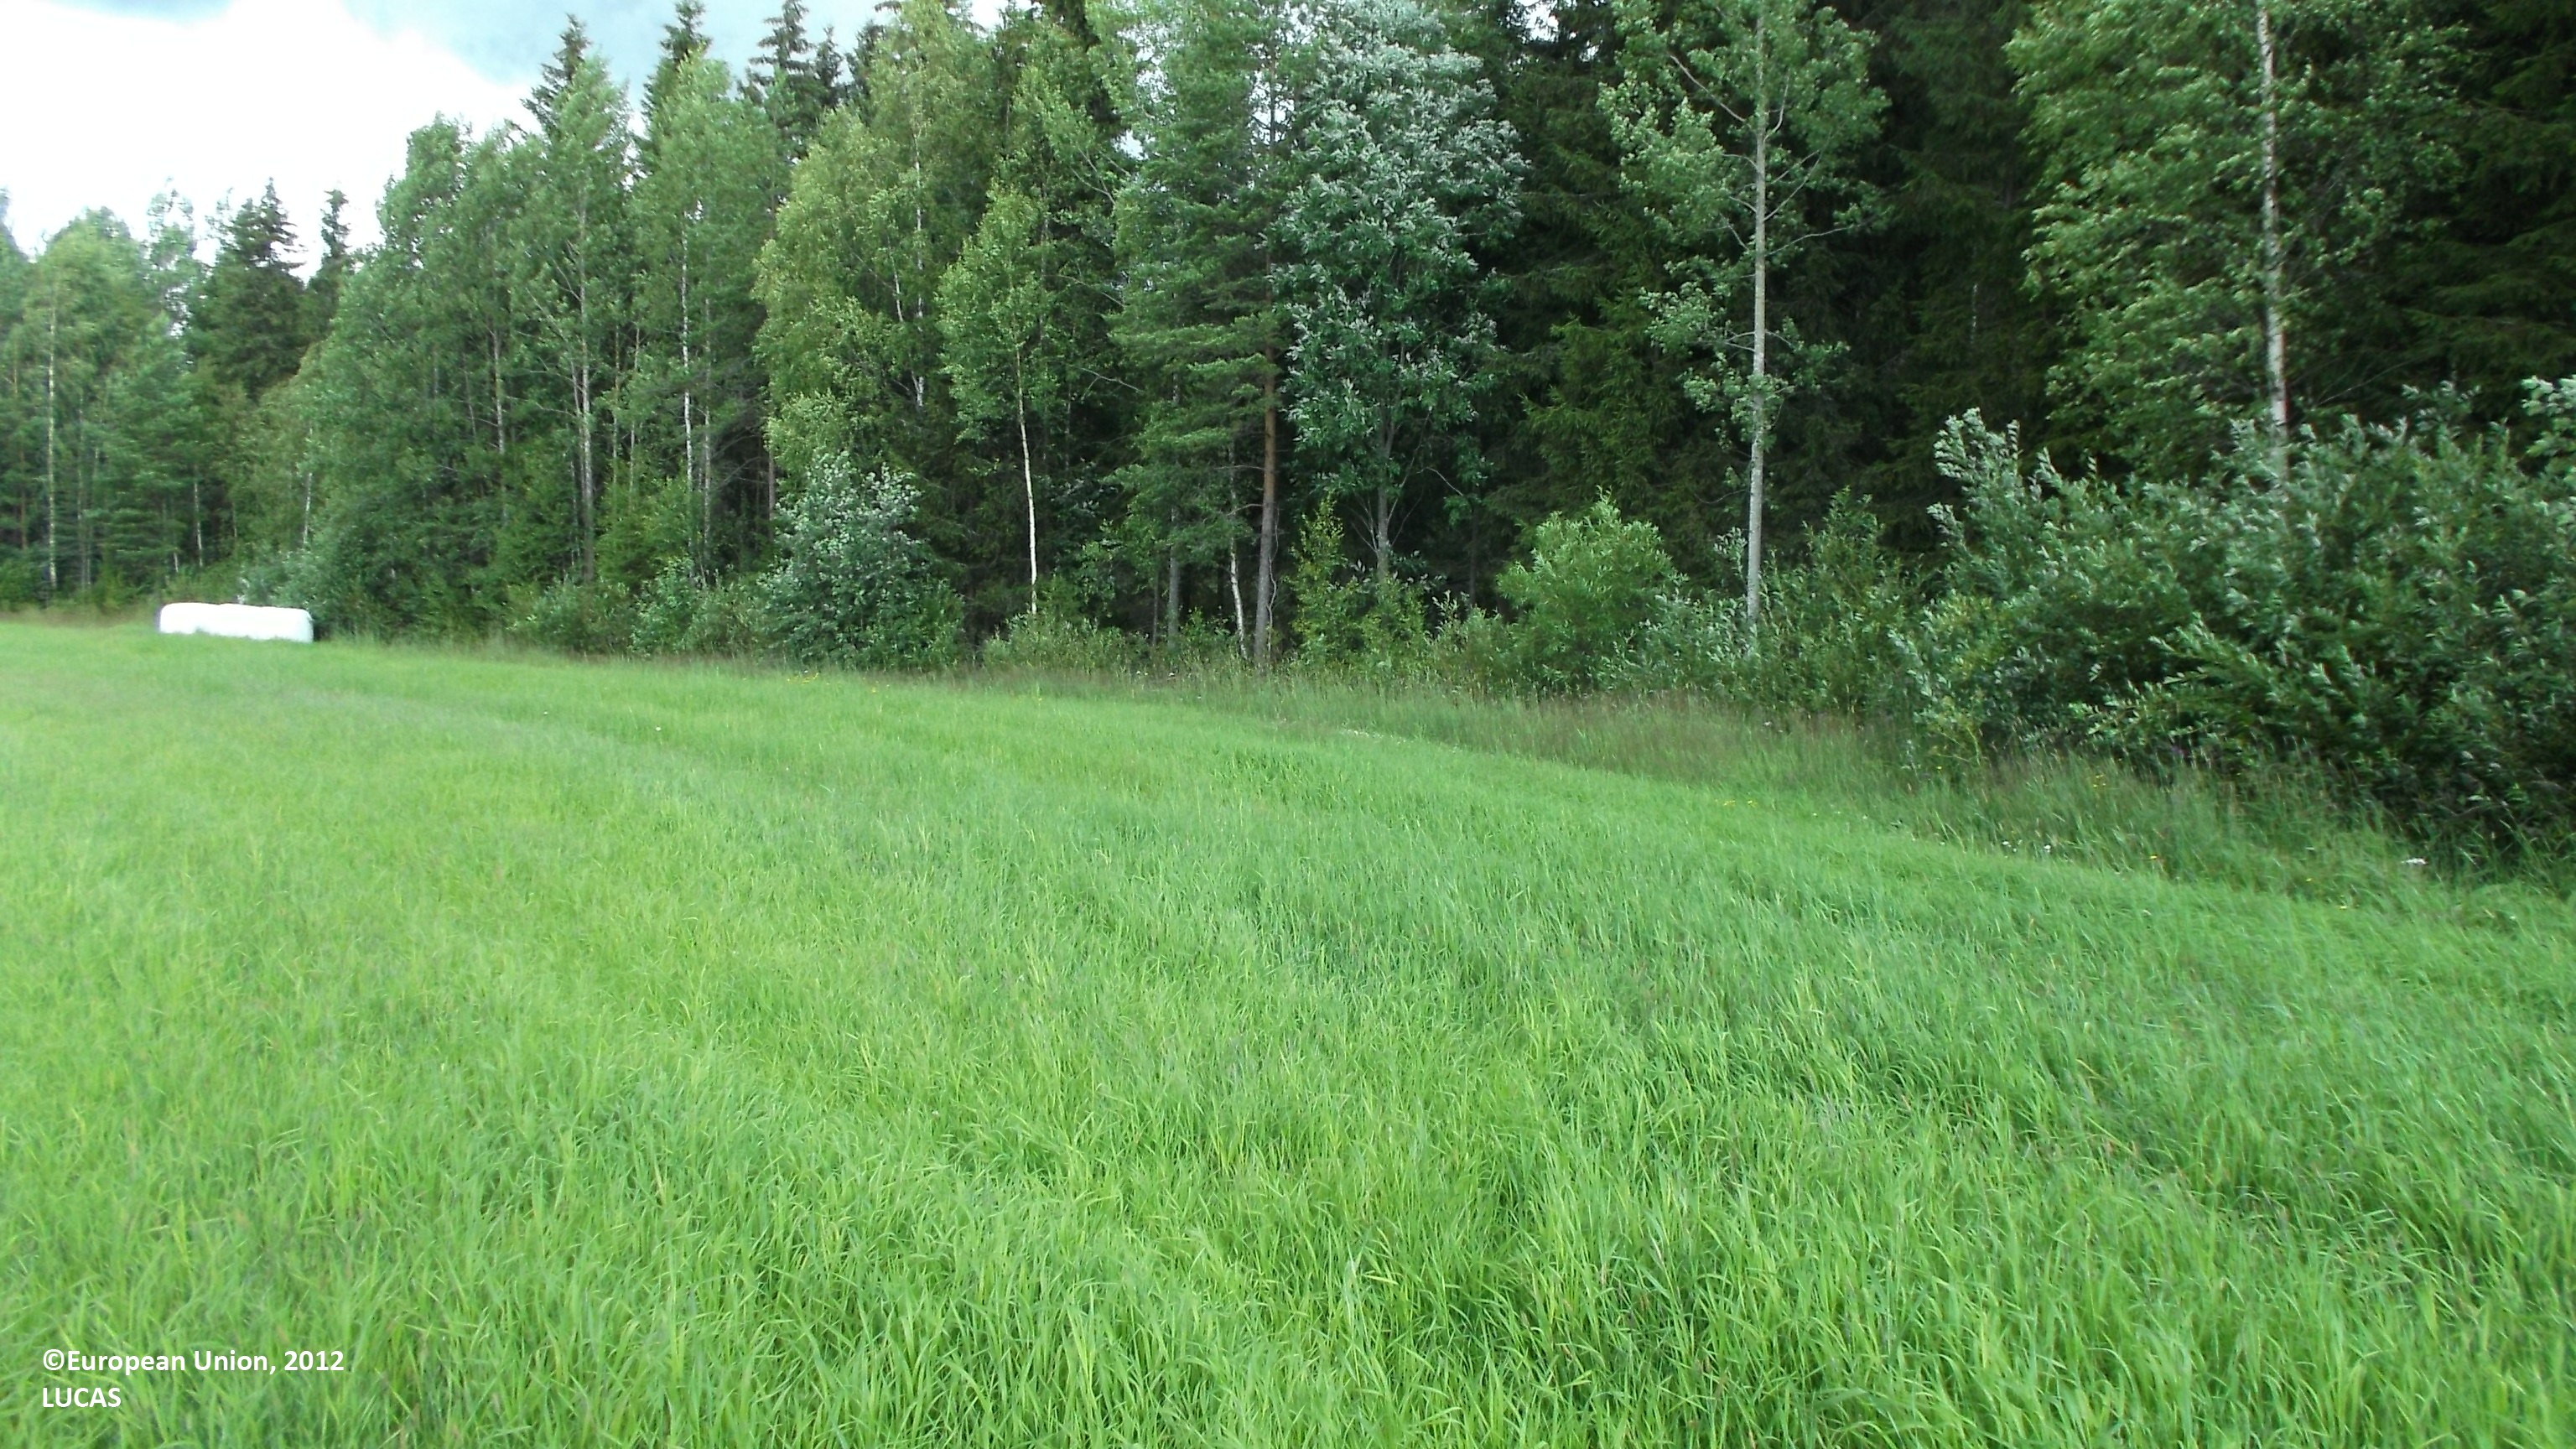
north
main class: Cropland
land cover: Temporary grasslands
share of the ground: > 75 %
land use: Agriculture (excluding fallow land and kitchen gardens)
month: July
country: FI
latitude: 63.6421
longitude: 23.1983
